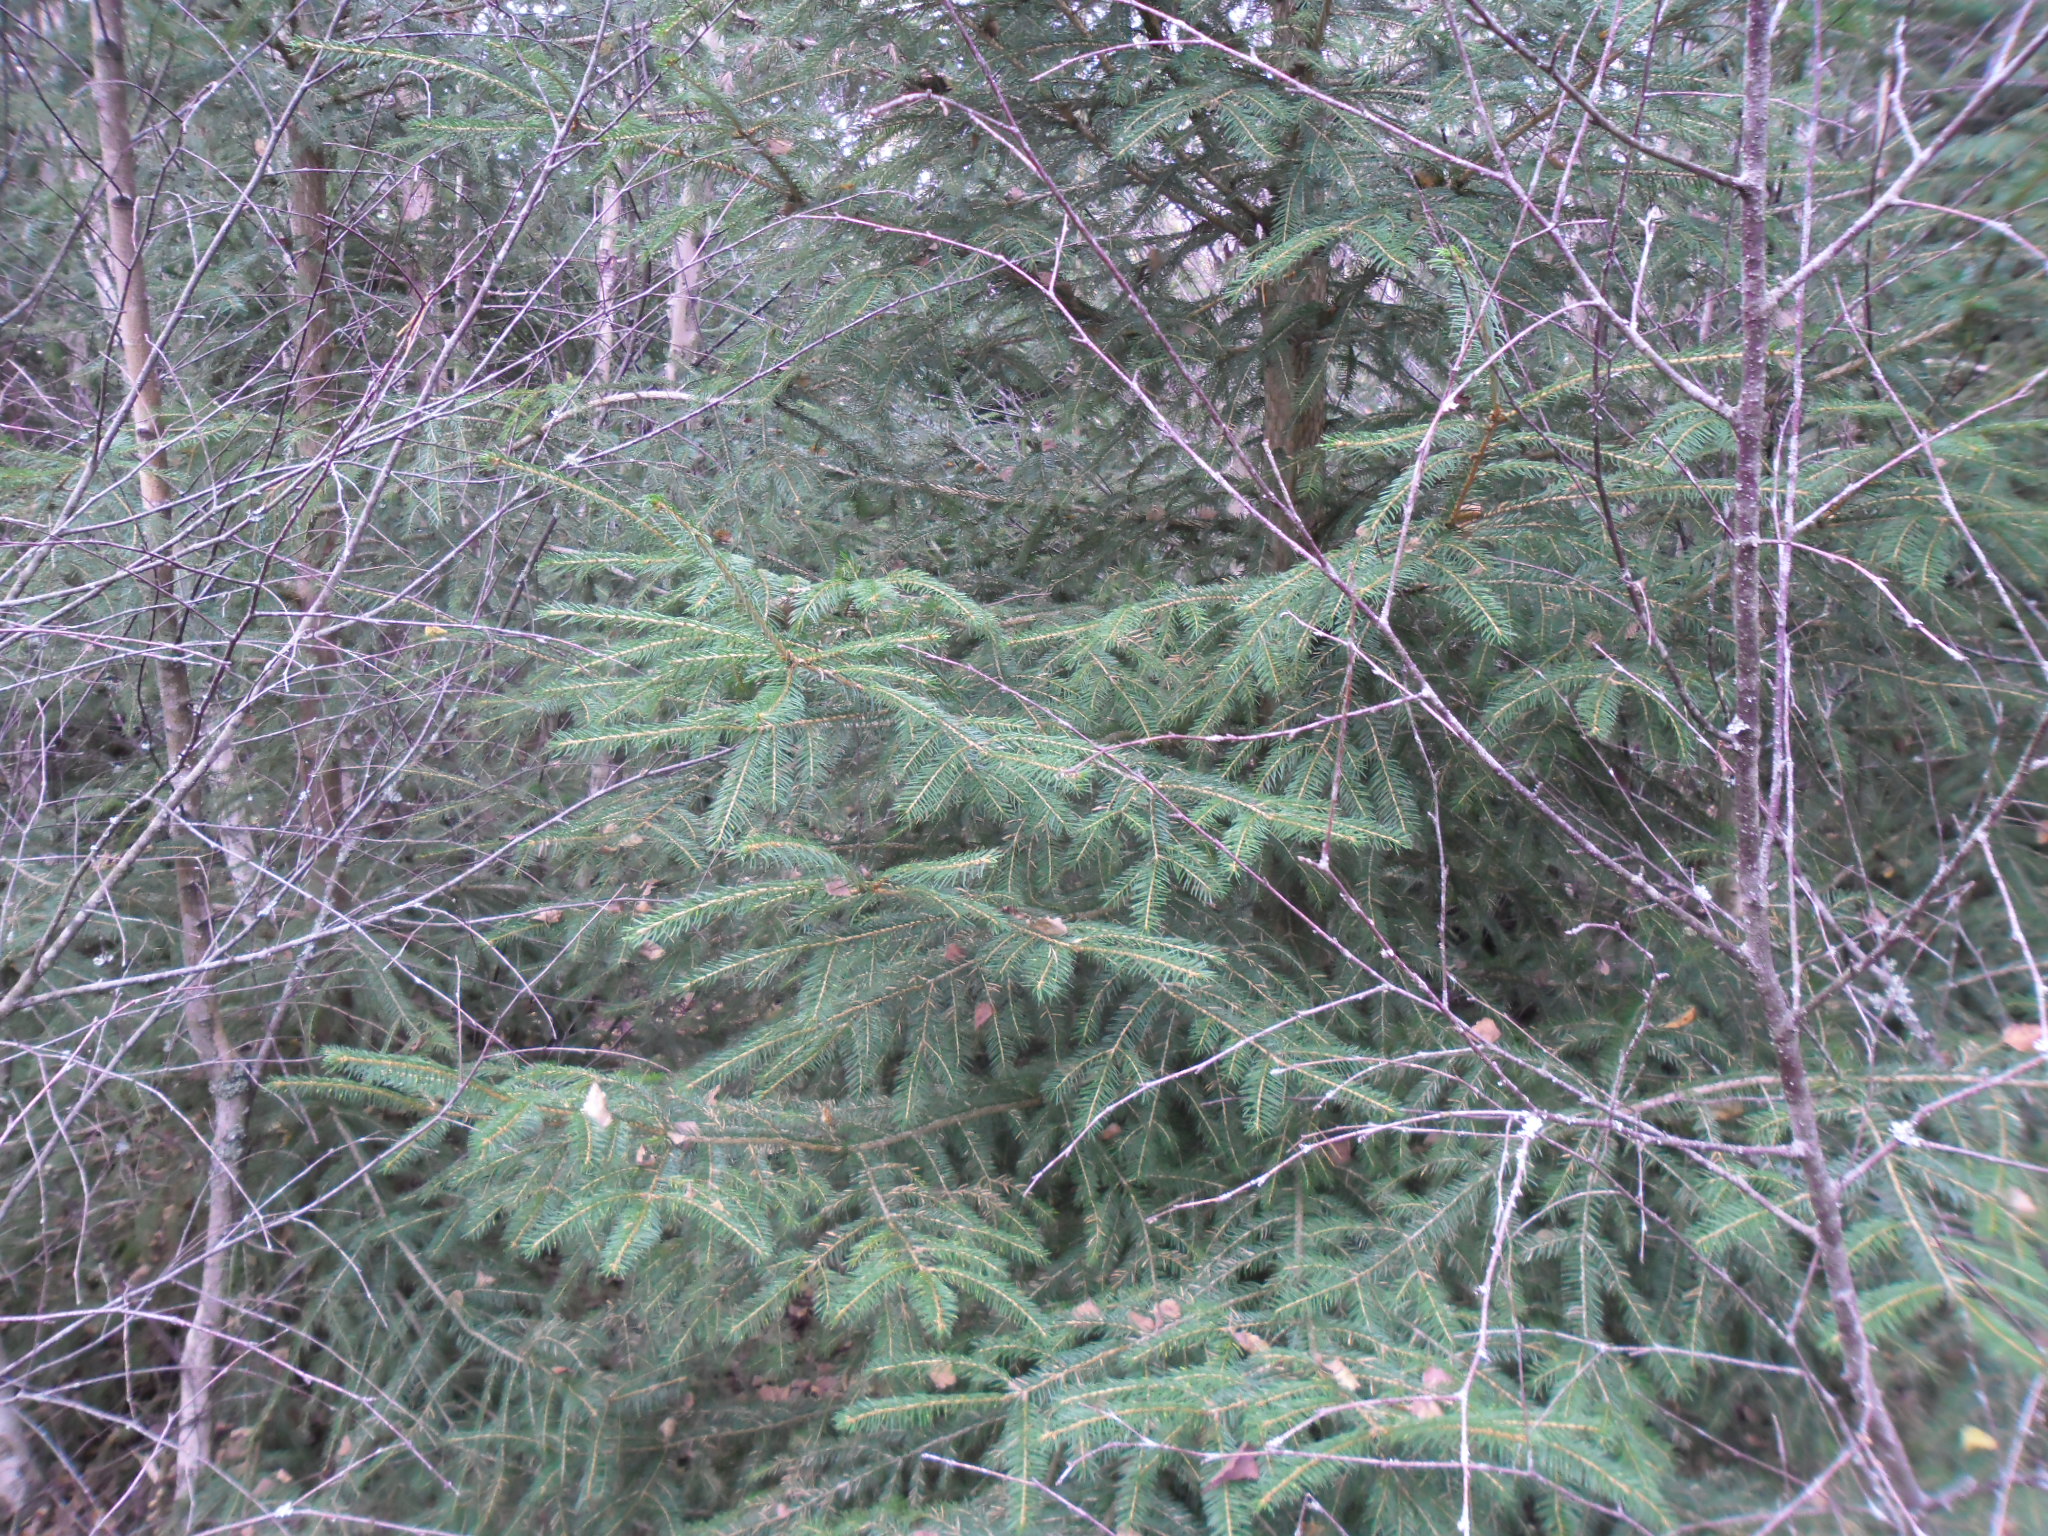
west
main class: Woodland
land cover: Spruce dominated mixed woodland
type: boreal forest
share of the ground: > 75 %
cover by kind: coniferous forest trees 60 %, broadleaved forest trees 30 %, herbaceous plants 10 %
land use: Forestry
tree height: < 5 m
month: October
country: SE
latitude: 56.2947
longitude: 13.7621
